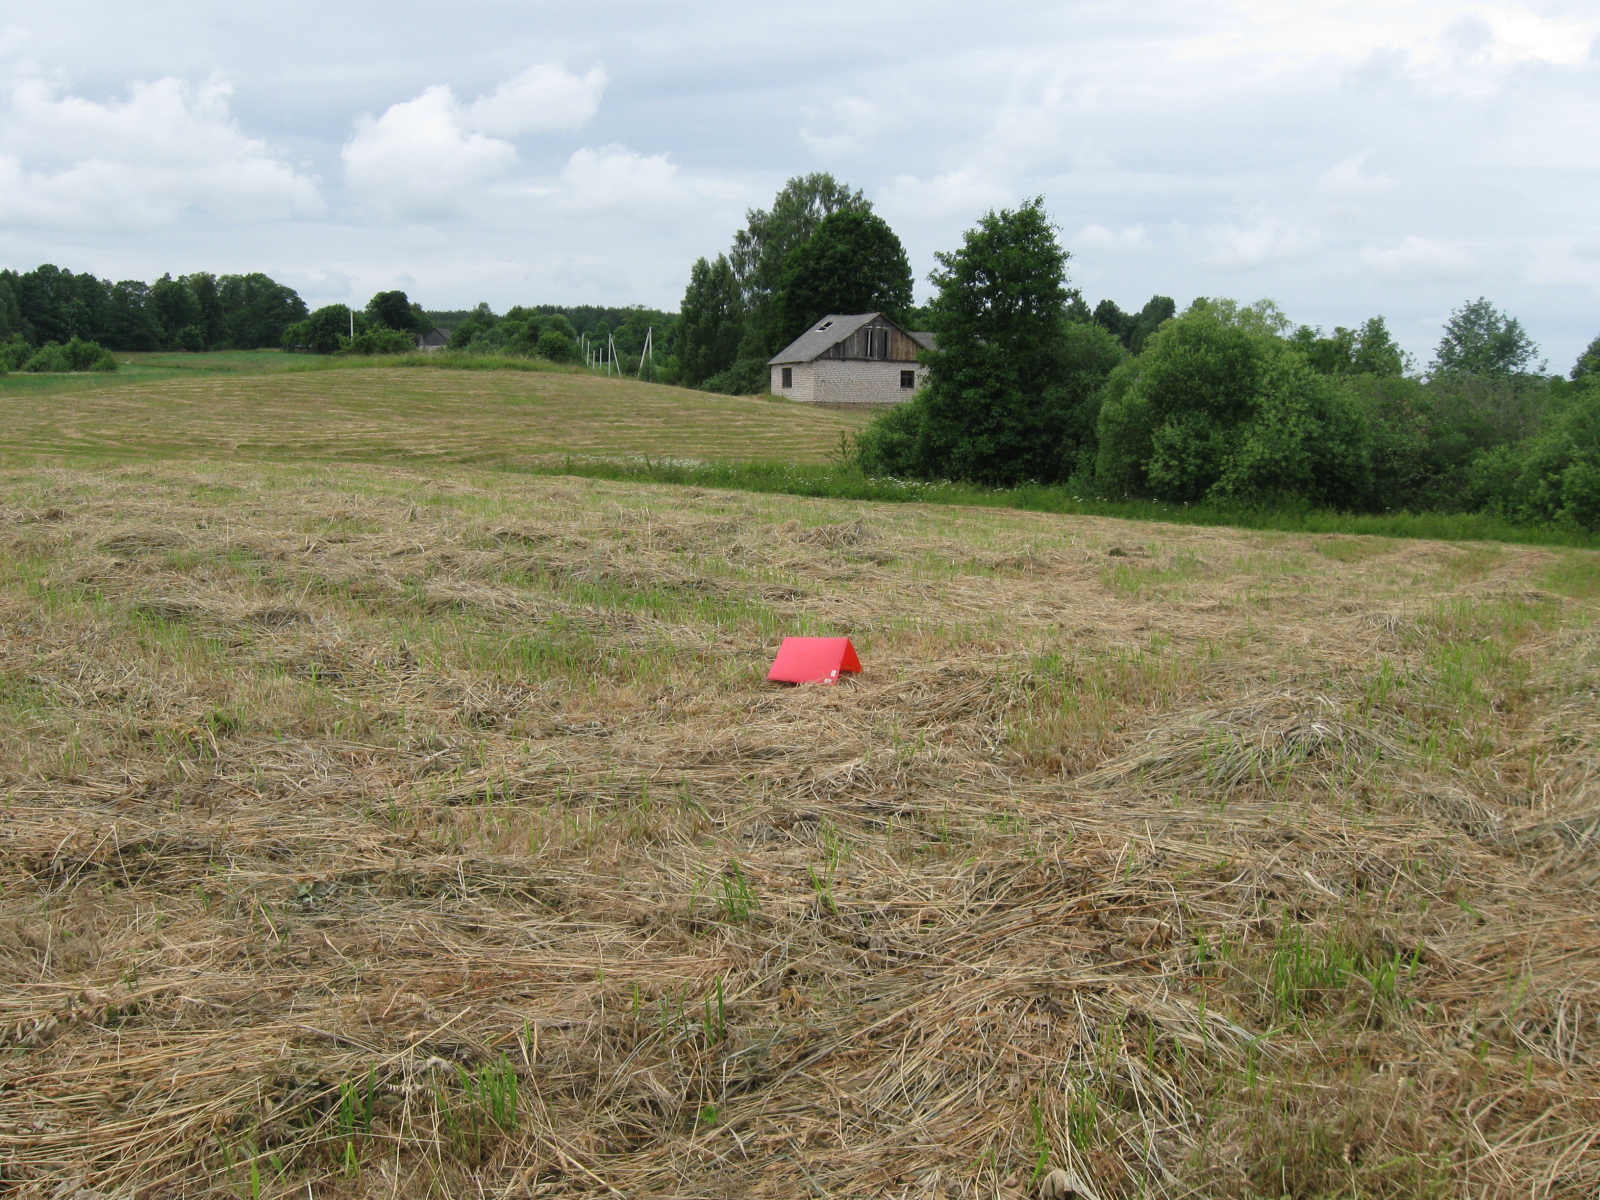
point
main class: Grassland
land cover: Grassland without tree/shrub cover
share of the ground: > 75 %
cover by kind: herbaceous plants 90 %, unconsolidated bare surface 10 %
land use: Agriculture (excluding fallow land and kitchen gardens)
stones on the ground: < 10 %
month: June
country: LT
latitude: 54.7709
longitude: 24.5124
